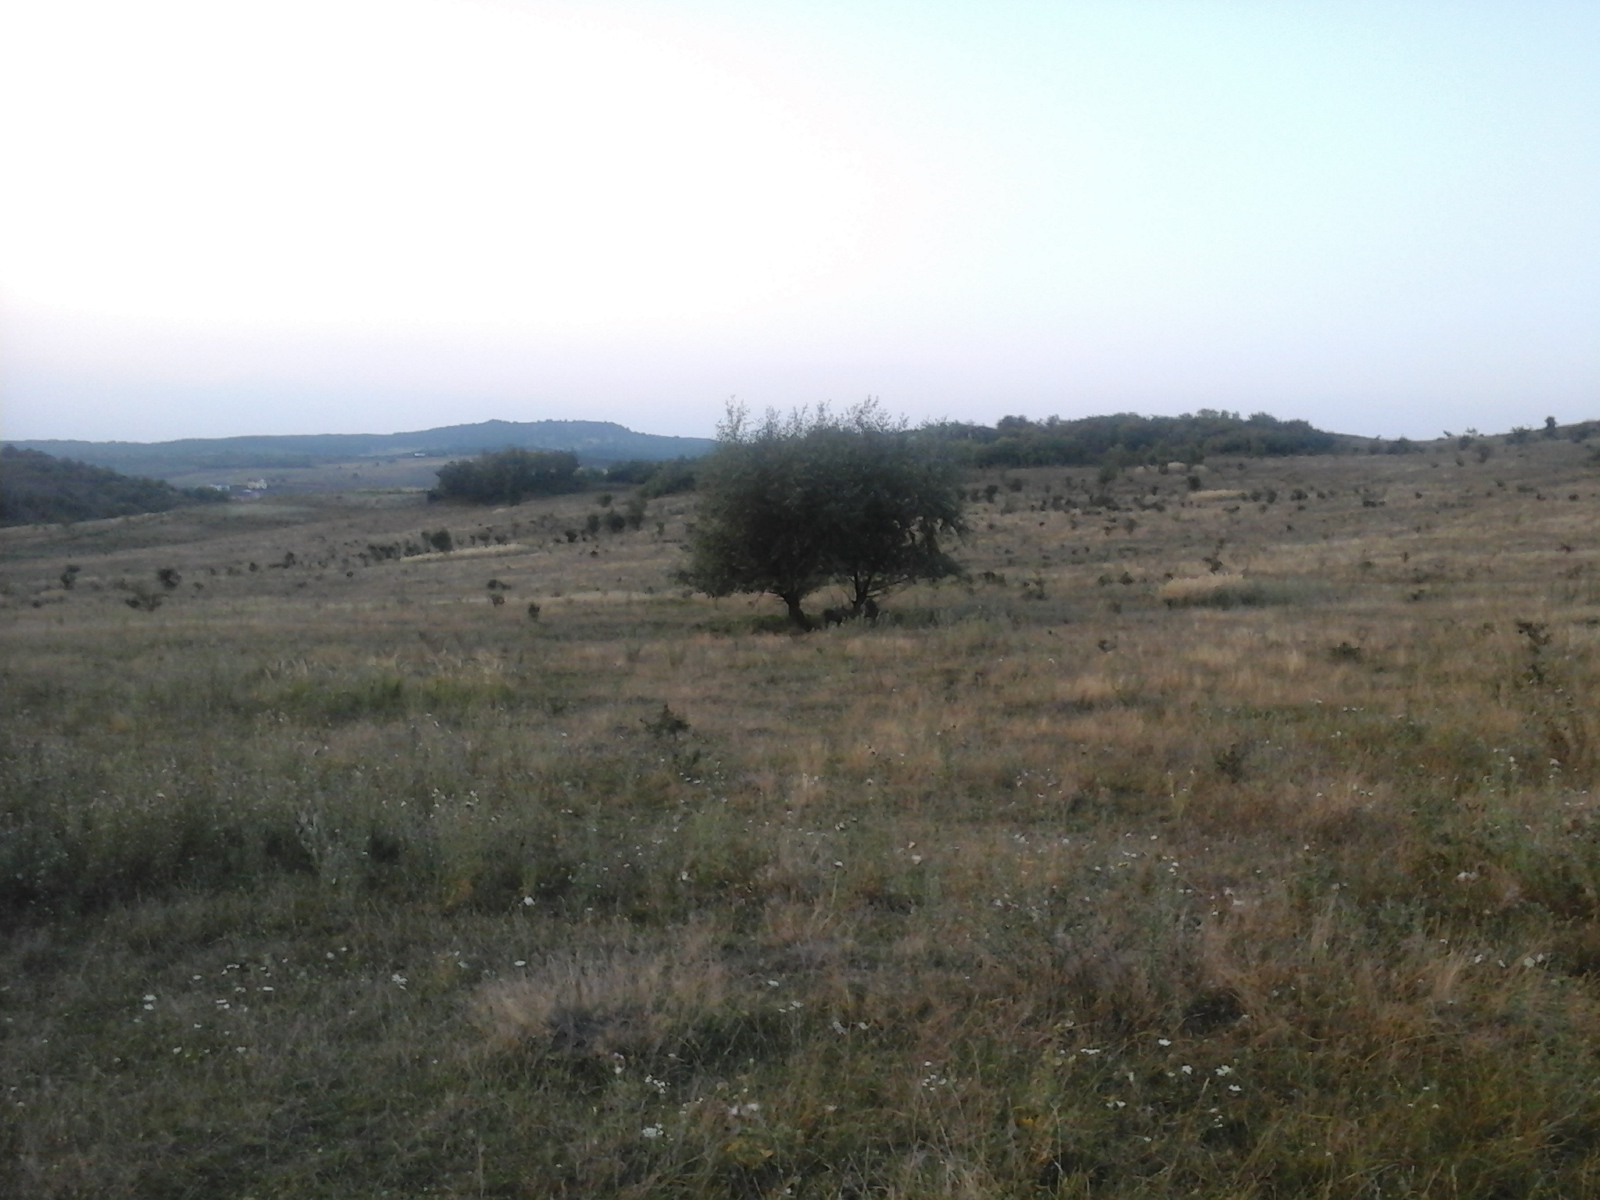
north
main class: Grassland
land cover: Grassland with sparse tree/shrub cover
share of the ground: > 75 %
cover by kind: herbaceous plants 95 %, broadleaved forest trees 5 %
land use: Agriculture (excluding fallow land and kitchen gardens)
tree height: < 5 m
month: September
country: RO
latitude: 47.1198
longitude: 24.4434
